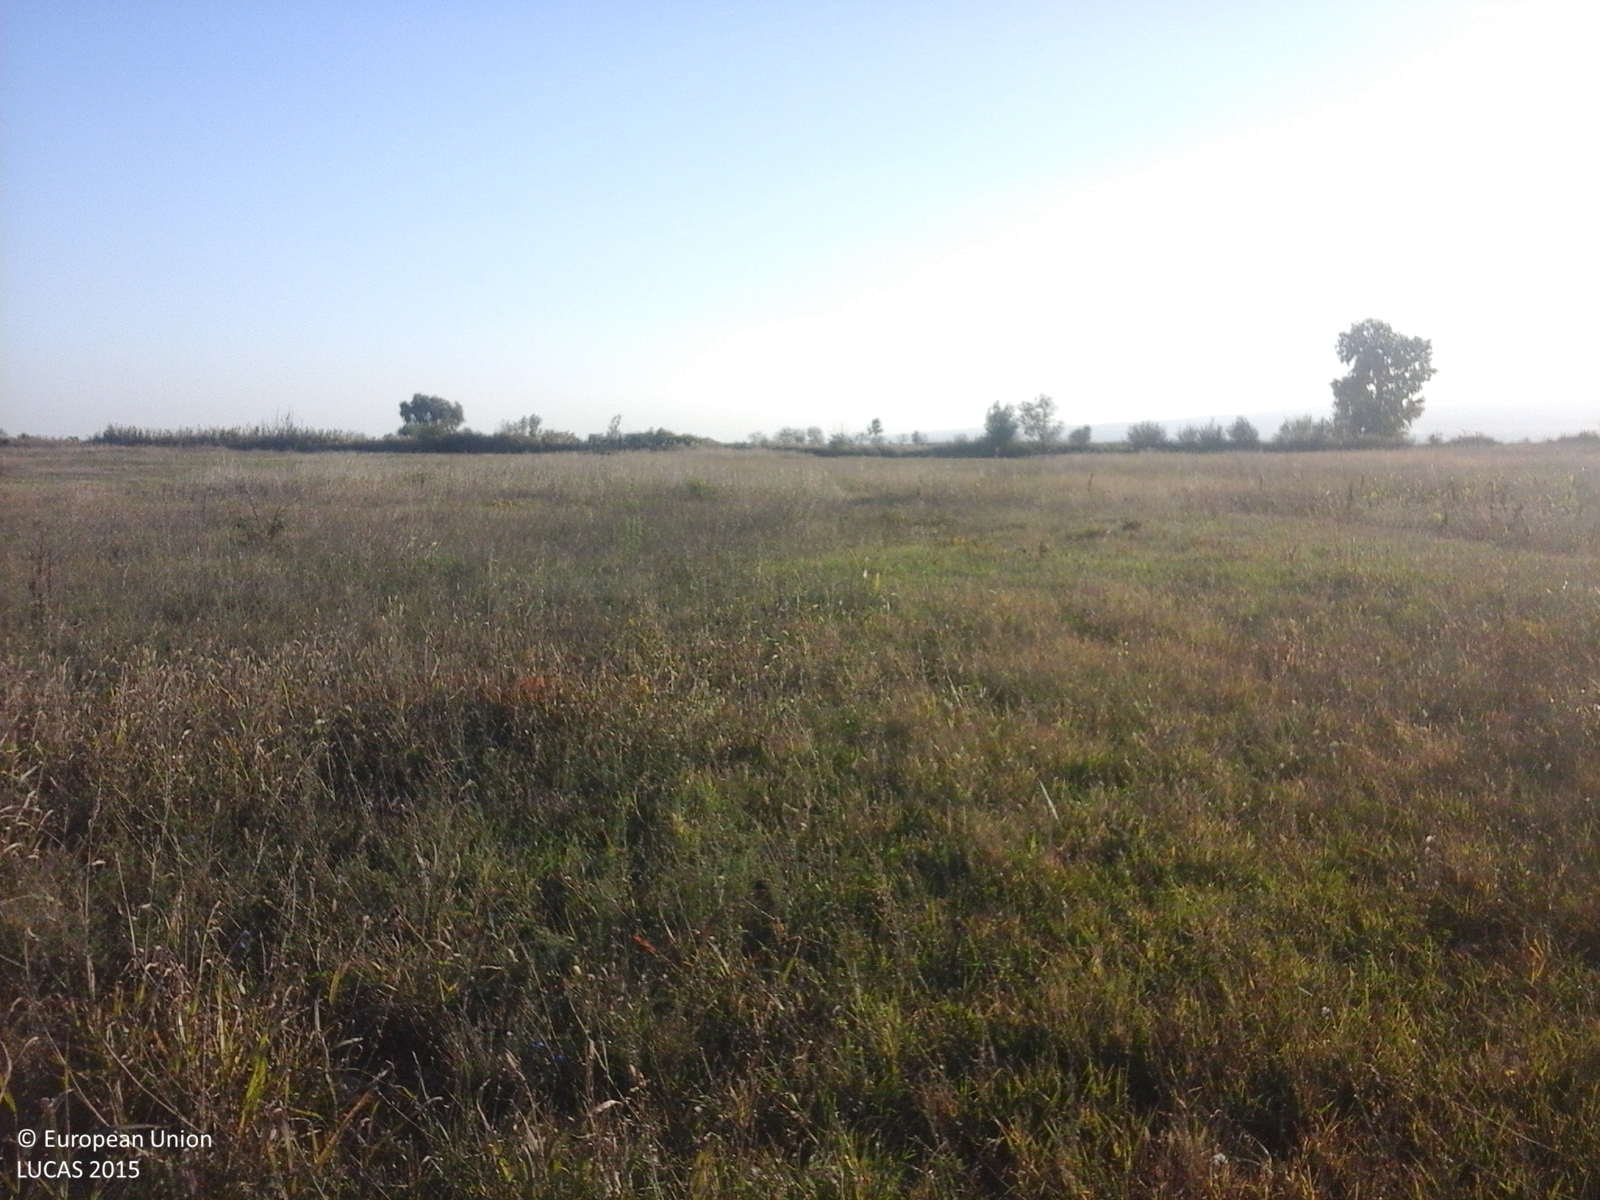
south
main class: Grassland
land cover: Spontaneously vegetated surfaces
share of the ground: > 75 %
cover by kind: herbaceous plants 100 %
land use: Fallow land
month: October
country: RO
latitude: 45.8219
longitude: 27.1227
